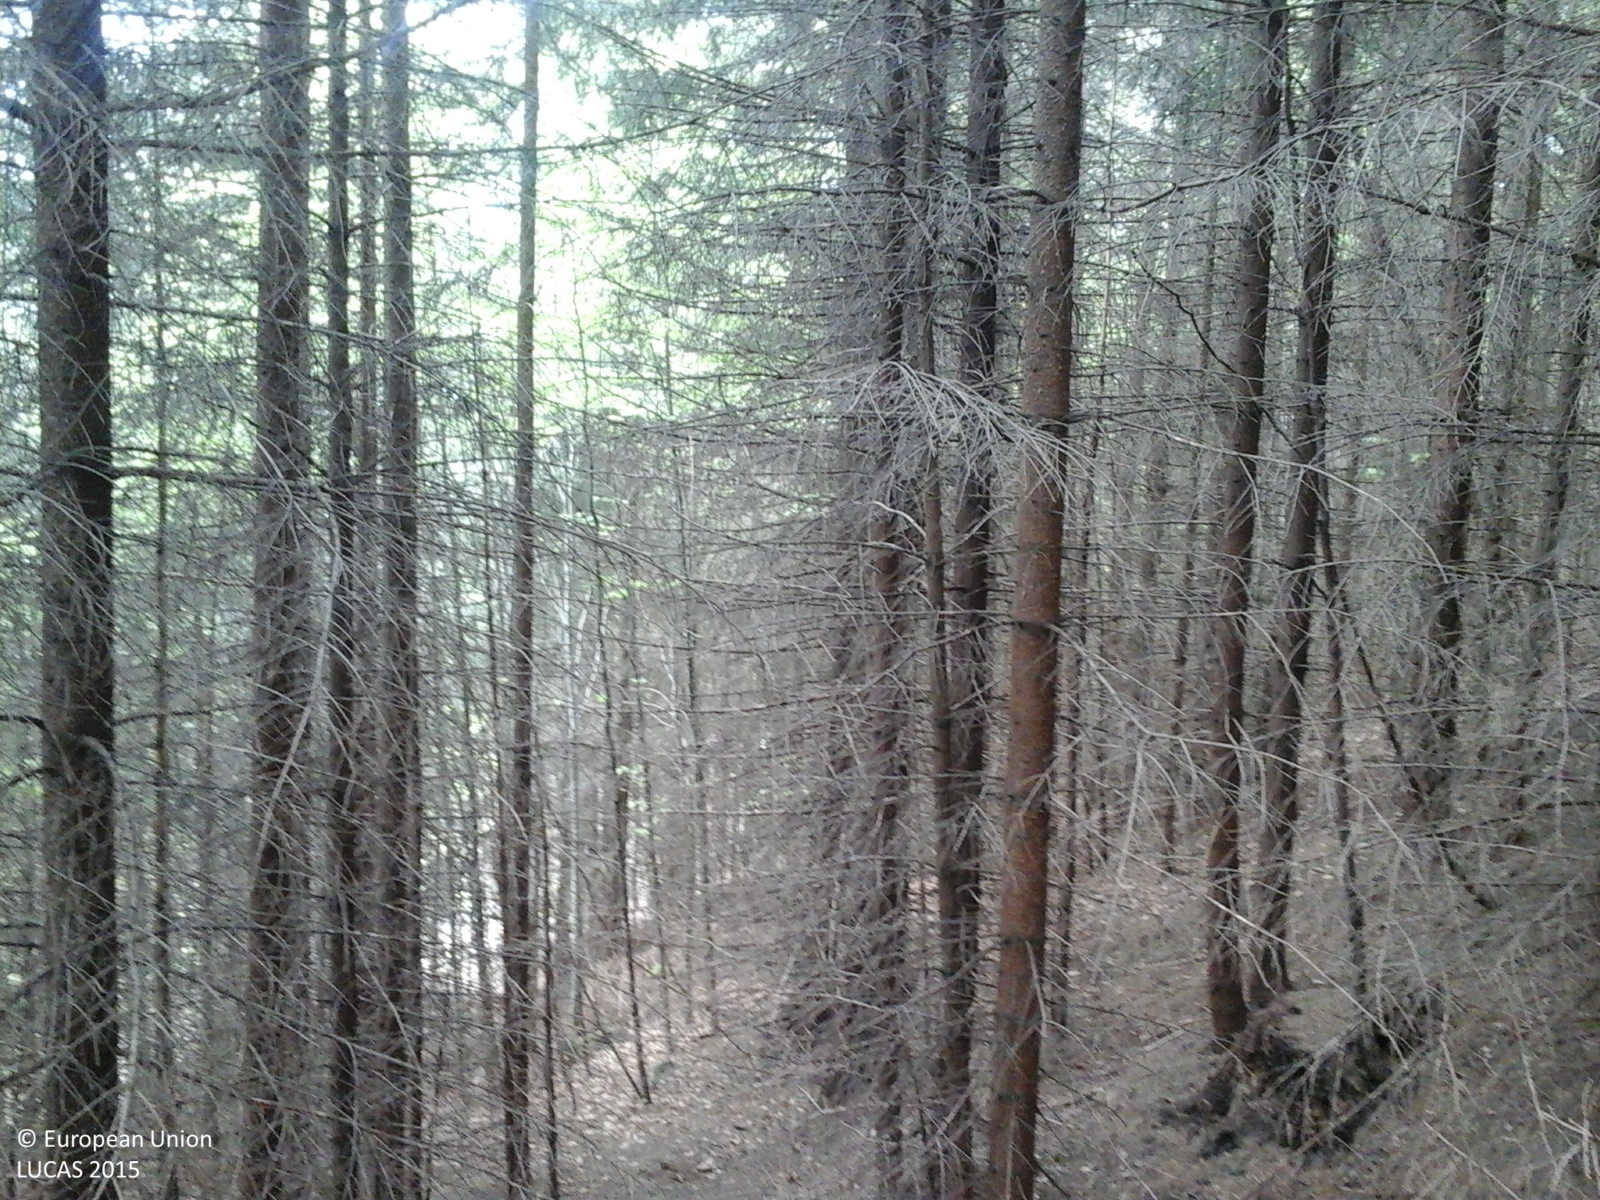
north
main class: Woodland
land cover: Spruce dominated mixed woodland
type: alpine coniferous forest
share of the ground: > 75 %
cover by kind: coniferous forest trees 75 %, broadleaved forest trees 25 %
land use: Forestry
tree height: > 5 m
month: May
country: RO
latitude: 45.7462
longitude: 26.3319
